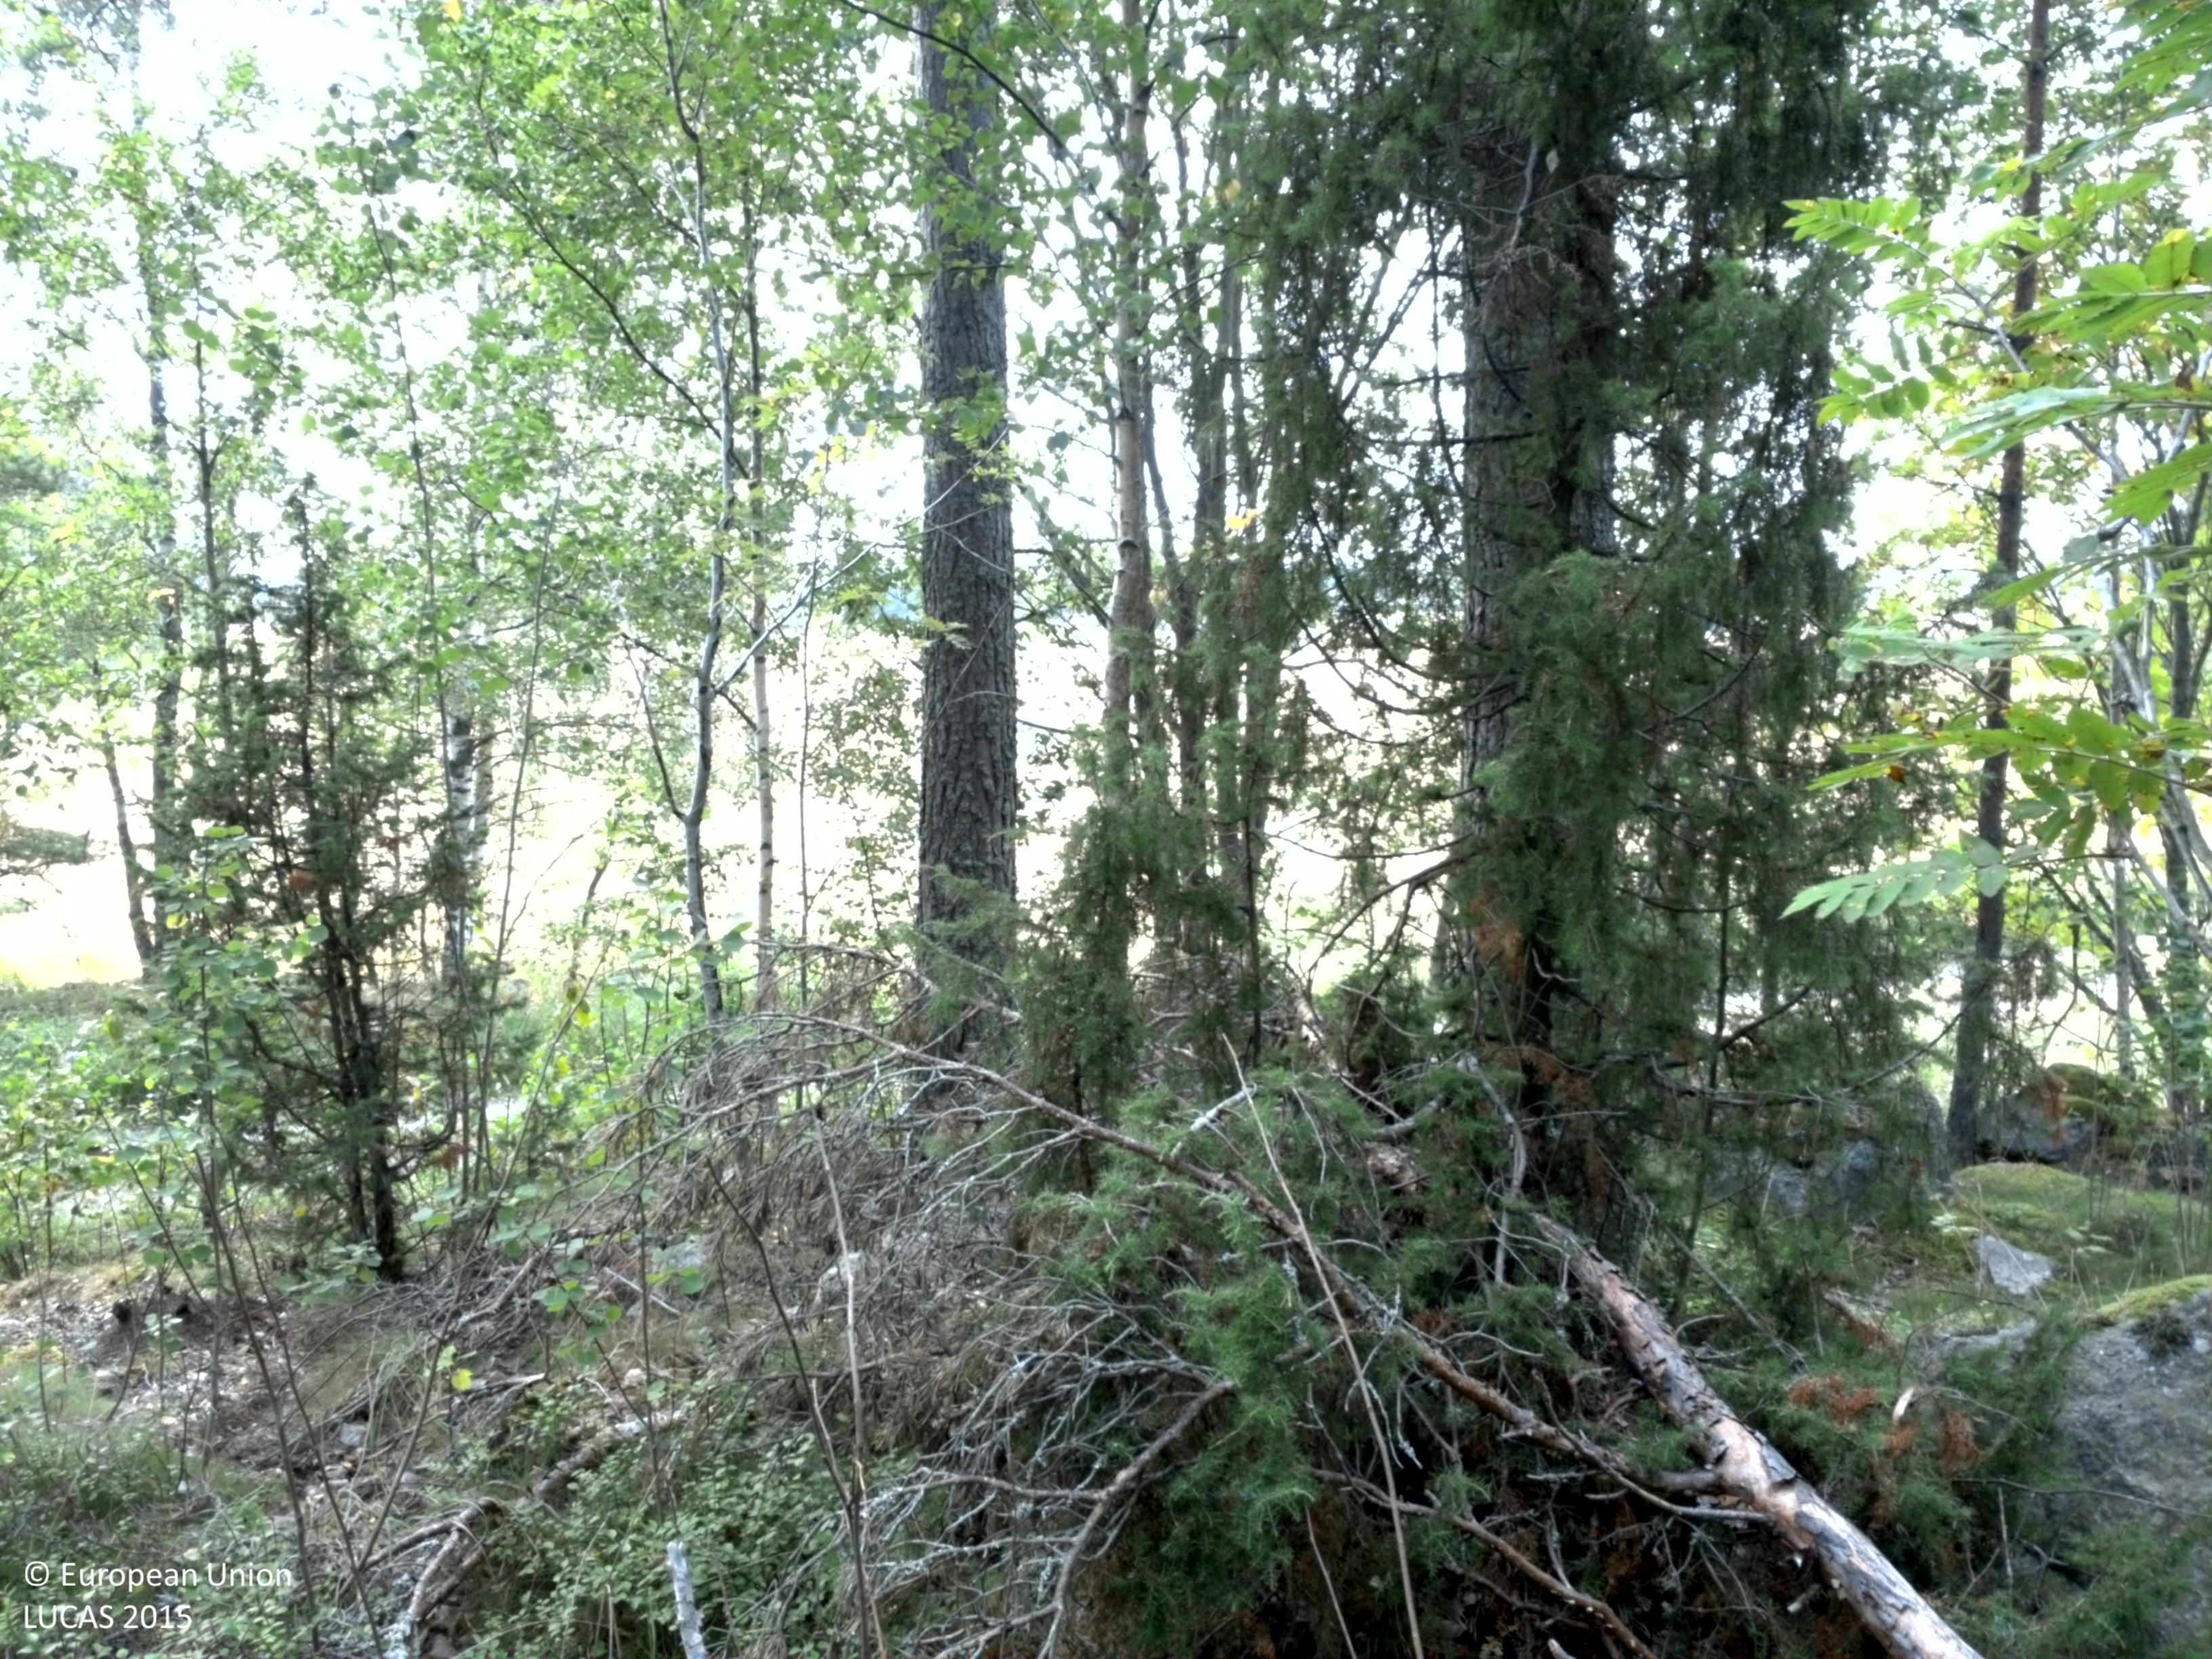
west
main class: Woodland
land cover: Spruce dominated mixed woodland
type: boreal forest
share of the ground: 50 - 75 %
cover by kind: coniferous forest trees 45 %, herbaceous plants 20 %, lichens and mosses 20 %, broadleaved forest trees 15 %
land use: Forestry
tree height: > 5 m
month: August
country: SE
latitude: 60.0090
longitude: 17.6520
